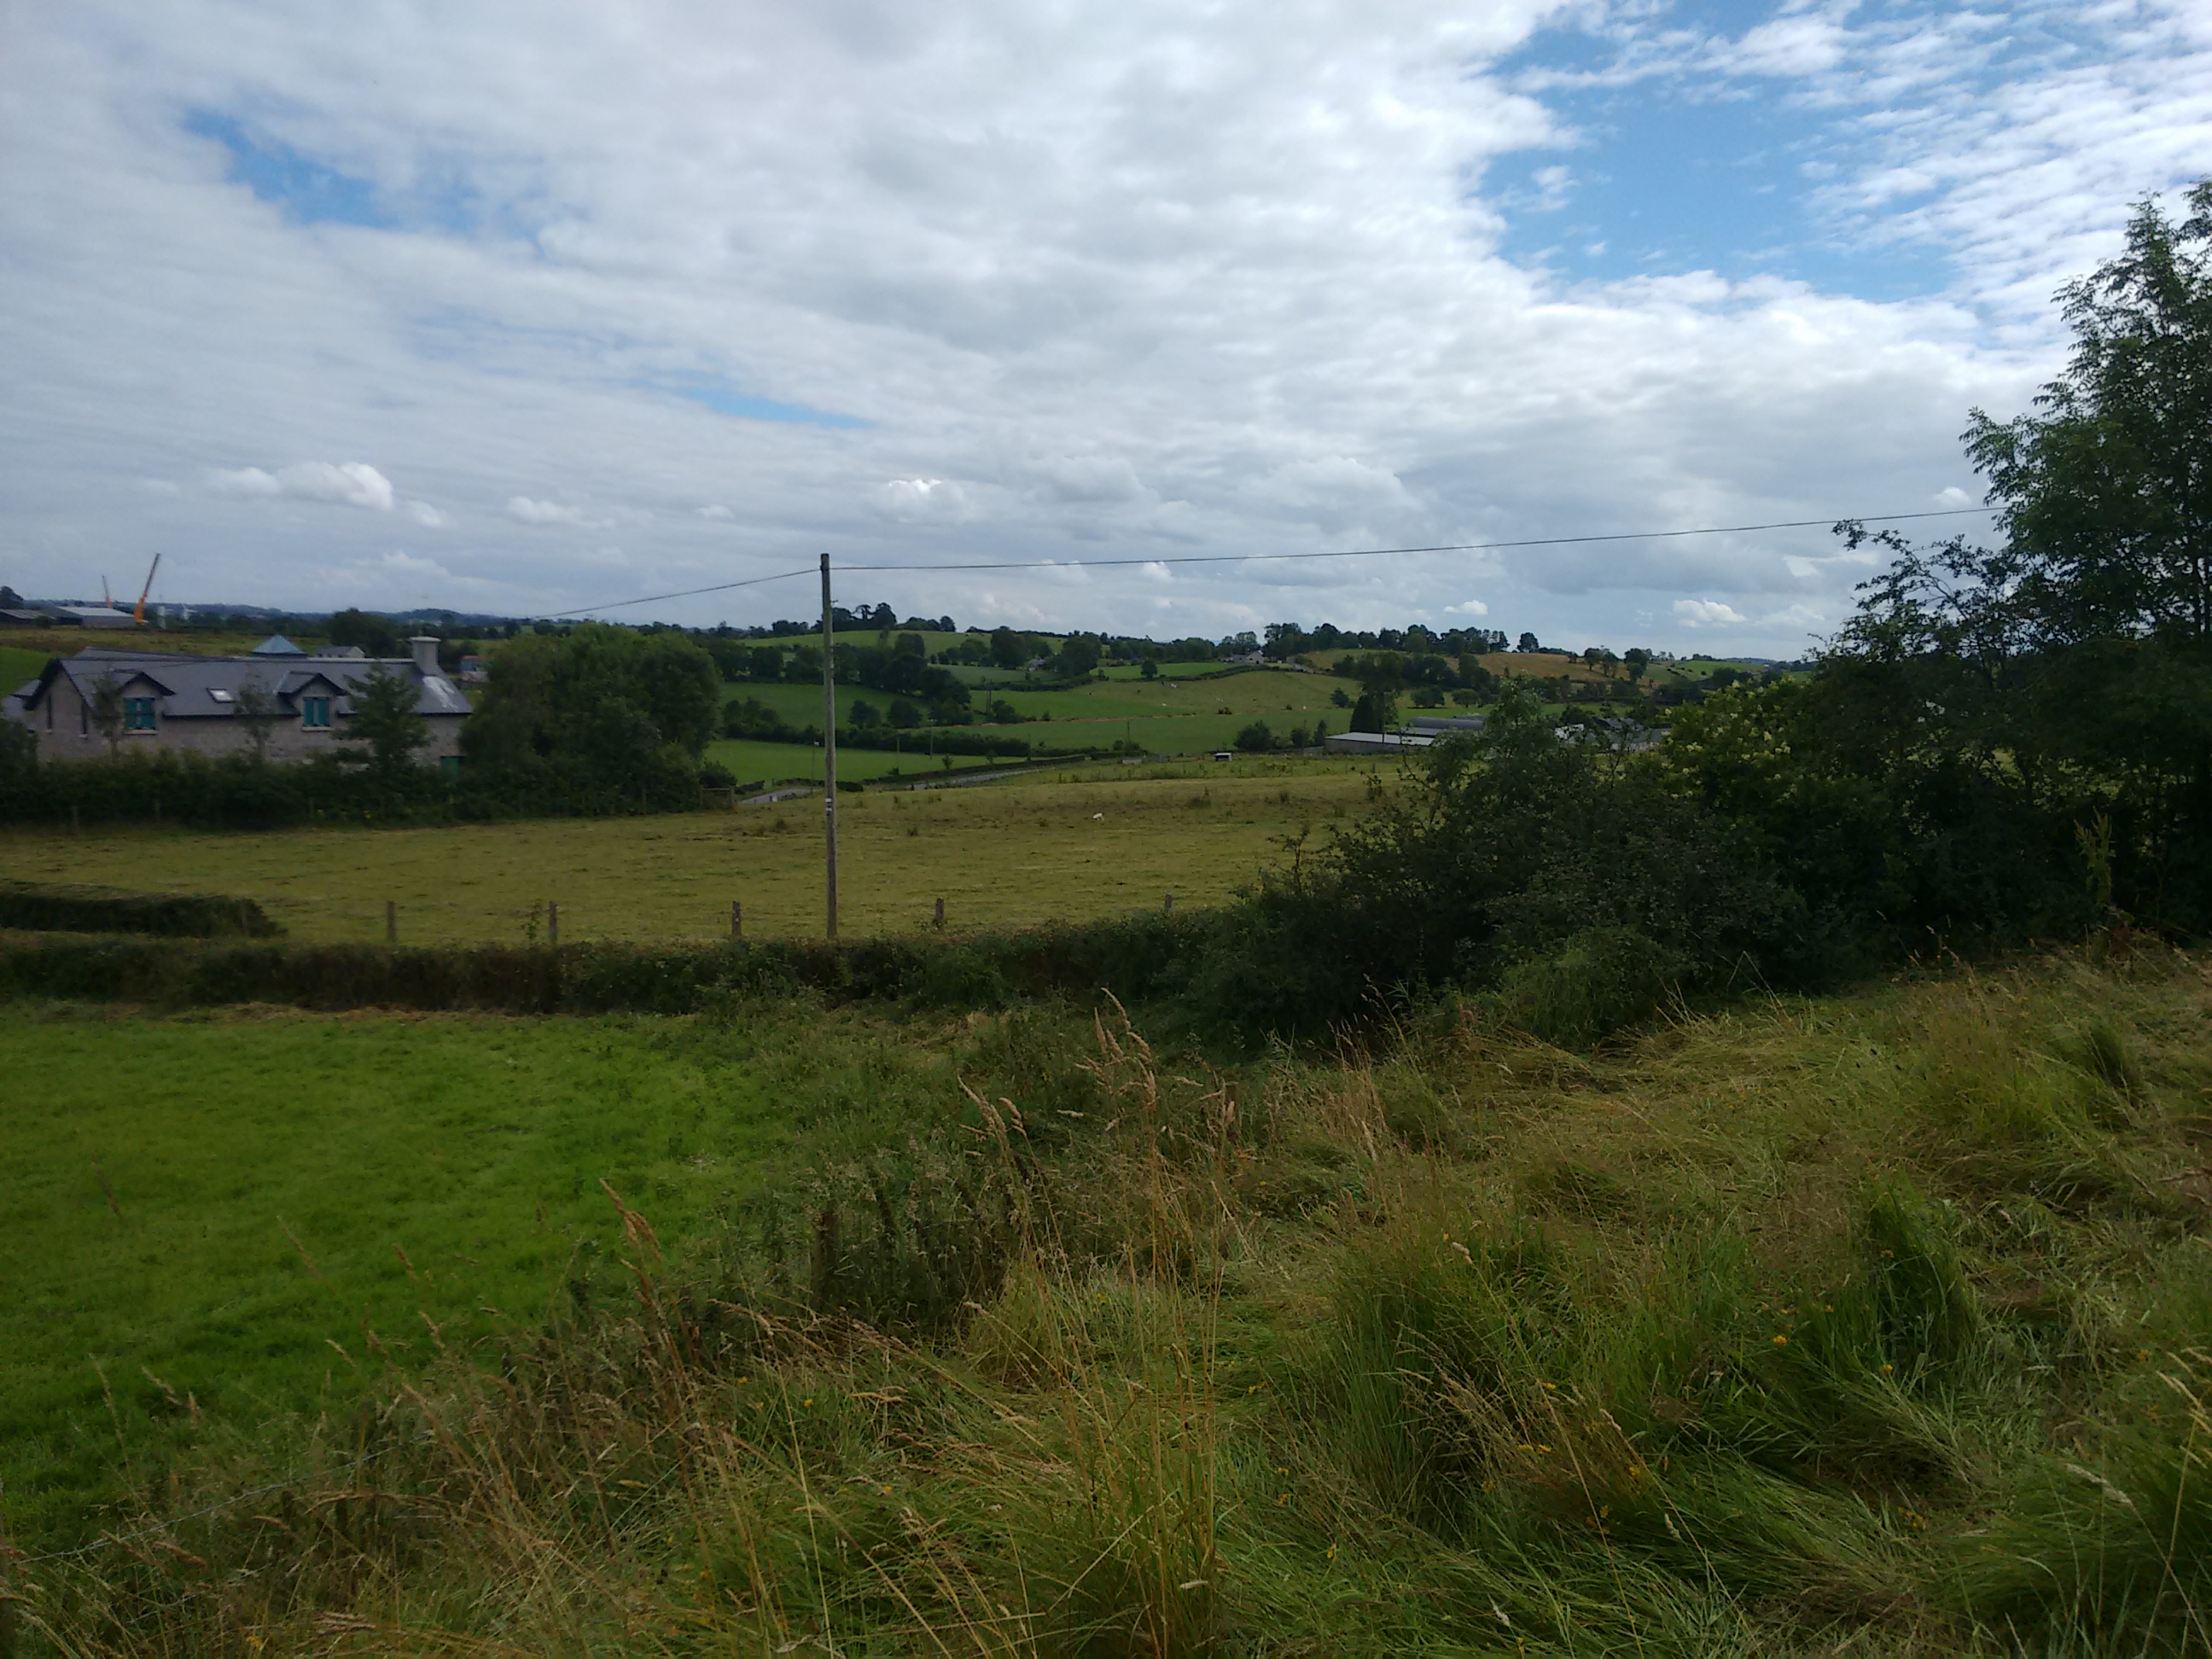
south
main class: Grassland
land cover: Grassland without tree/shrub cover
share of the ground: > 75 %
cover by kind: herbaceous plants 100 %
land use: Agriculture (excluding fallow land and kitchen gardens)
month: August
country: GB
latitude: 54.5593
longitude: -6.8830
